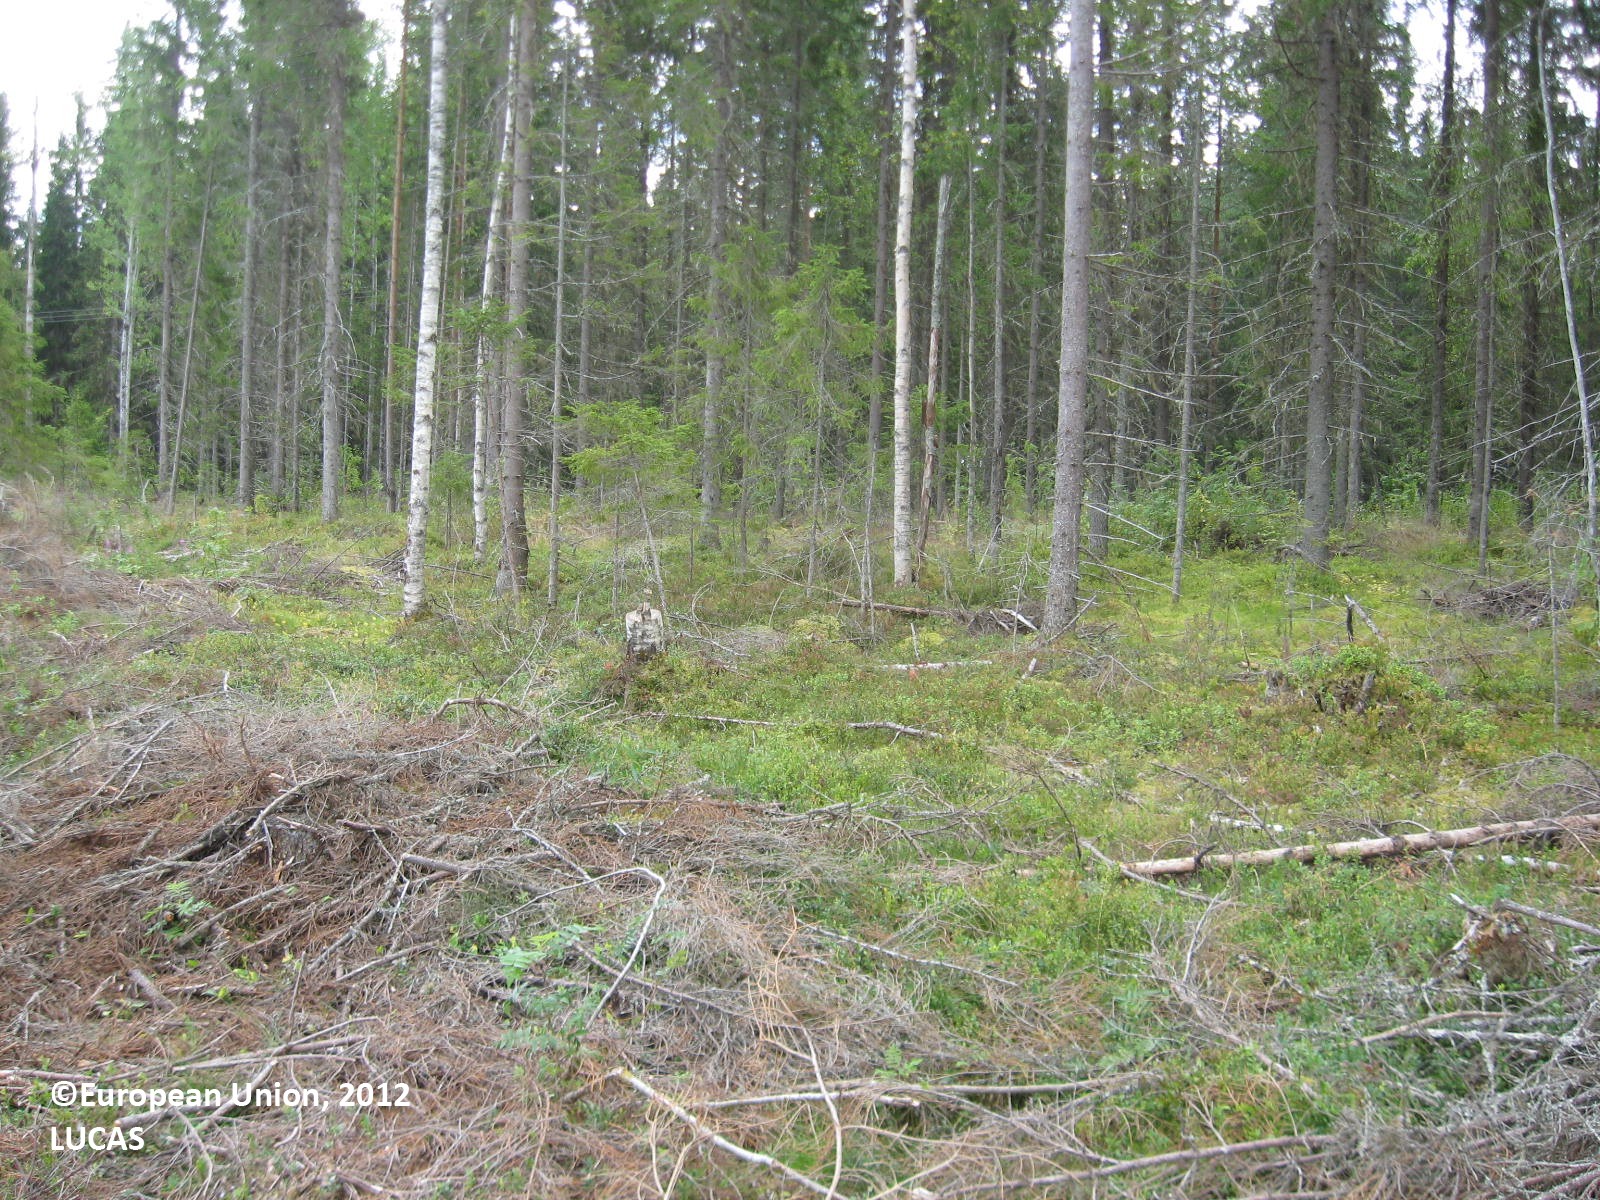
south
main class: Grassland
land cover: Grassland with sparse tree/shrub cover
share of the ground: 50 - 75 %
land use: Forestry
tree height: < 5 m
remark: Clear cut
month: August
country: FI
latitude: 63.3380
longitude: 29.6301
